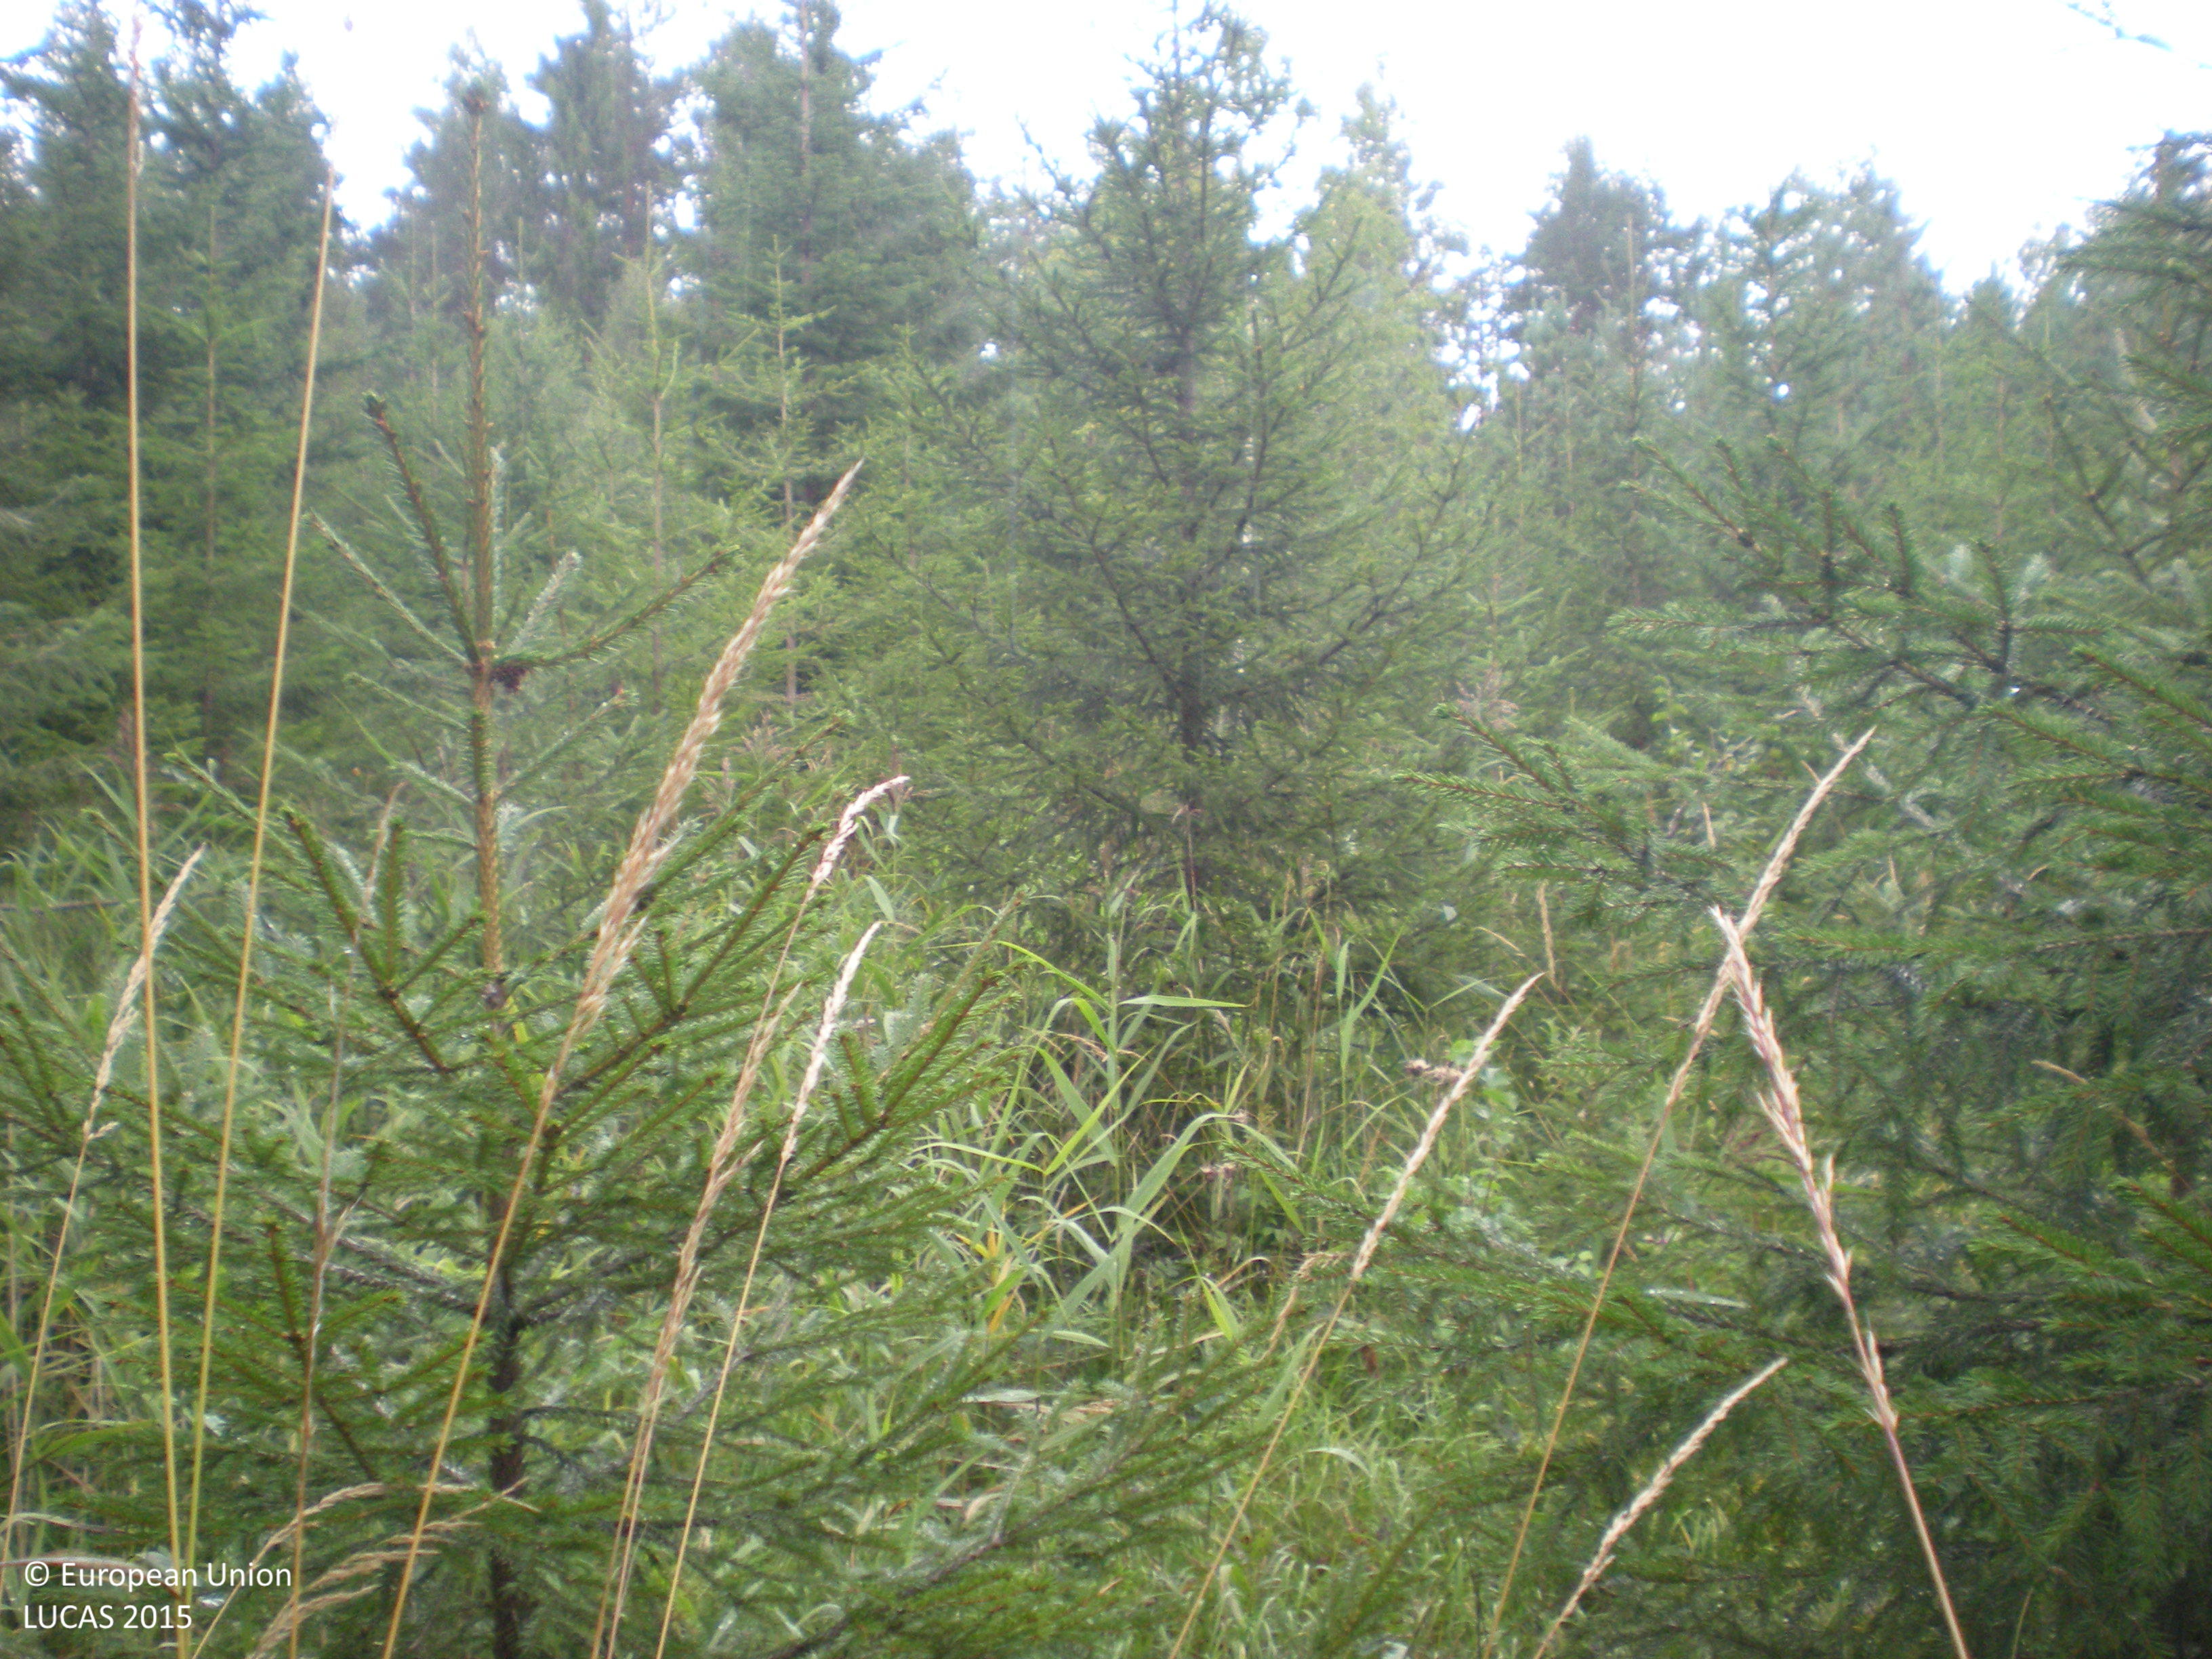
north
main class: Woodland
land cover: Spruce dominated mixed woodland
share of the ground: 50 - 75 %
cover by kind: coniferous forest trees 55 %, herbaceous plants 25 %, broadleaved forest trees 20 %
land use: Forestry
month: August
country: SE
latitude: 60.5256
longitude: 17.1136
